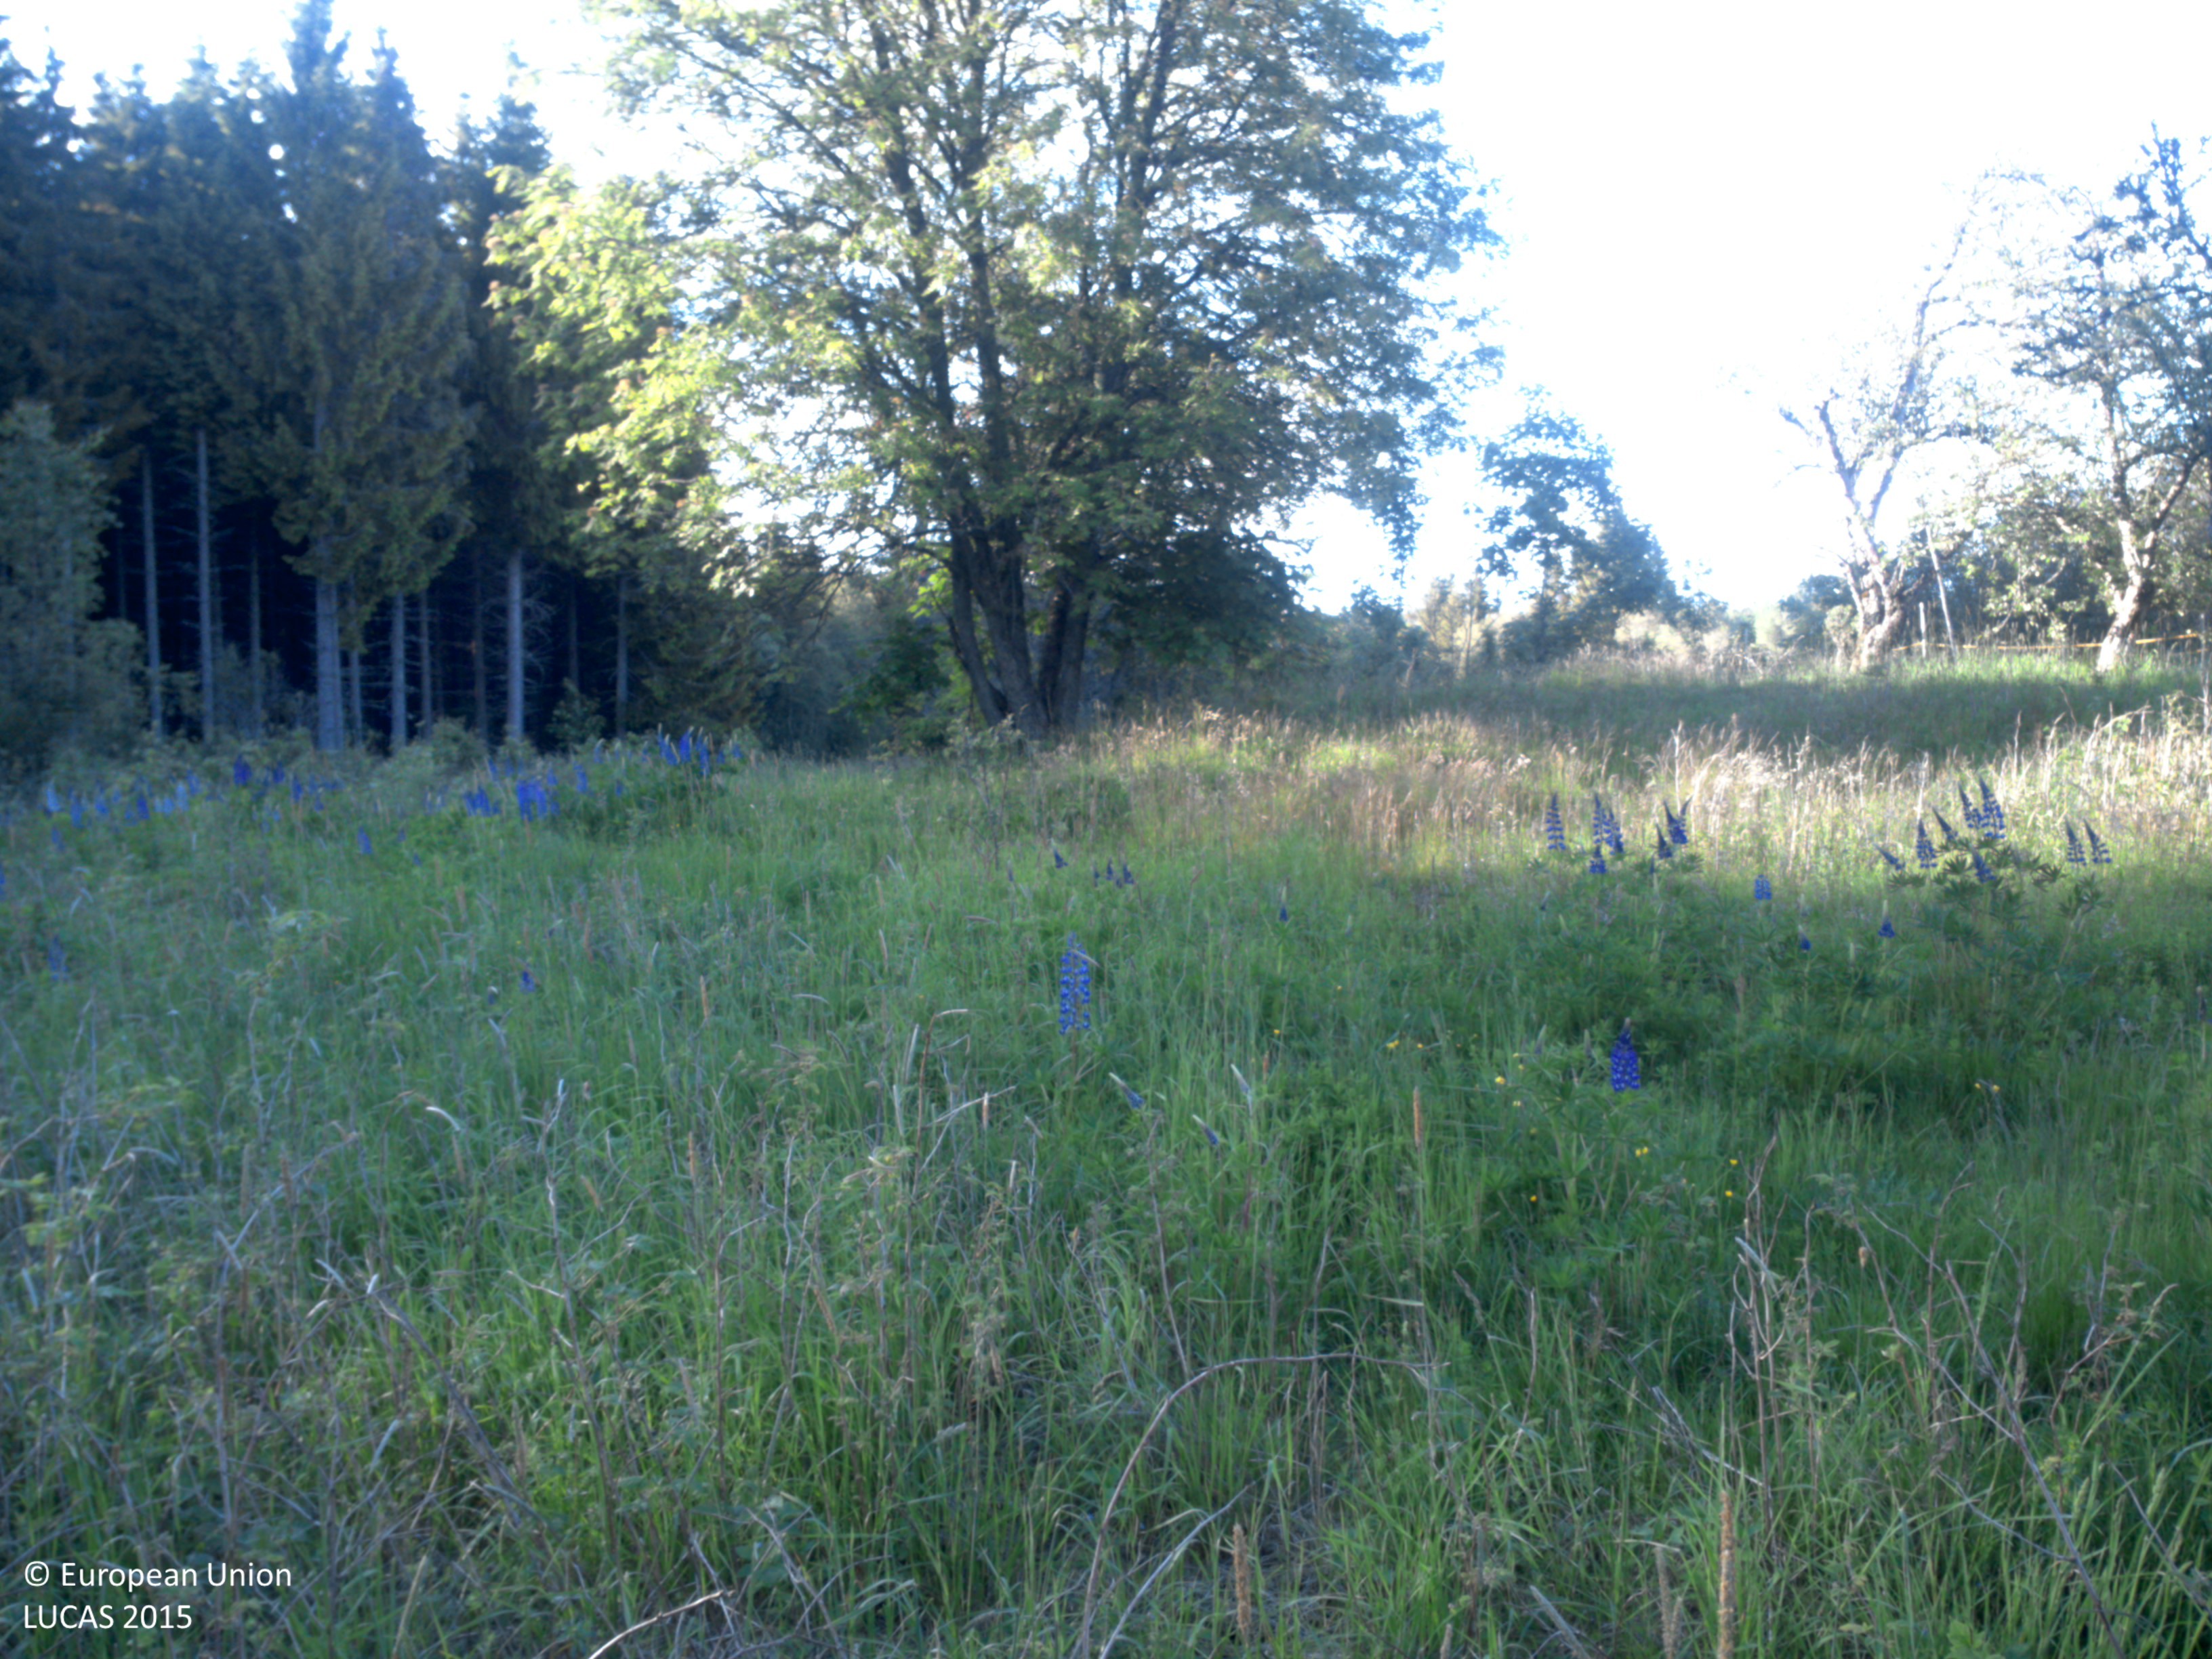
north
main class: Grassland
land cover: Spontaneously vegetated surfaces
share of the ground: > 75 %
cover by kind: herbaceous plants 95 %, shrubs 5 %
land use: Fallow land
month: June
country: SE
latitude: 58.9628
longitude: 11.8215
